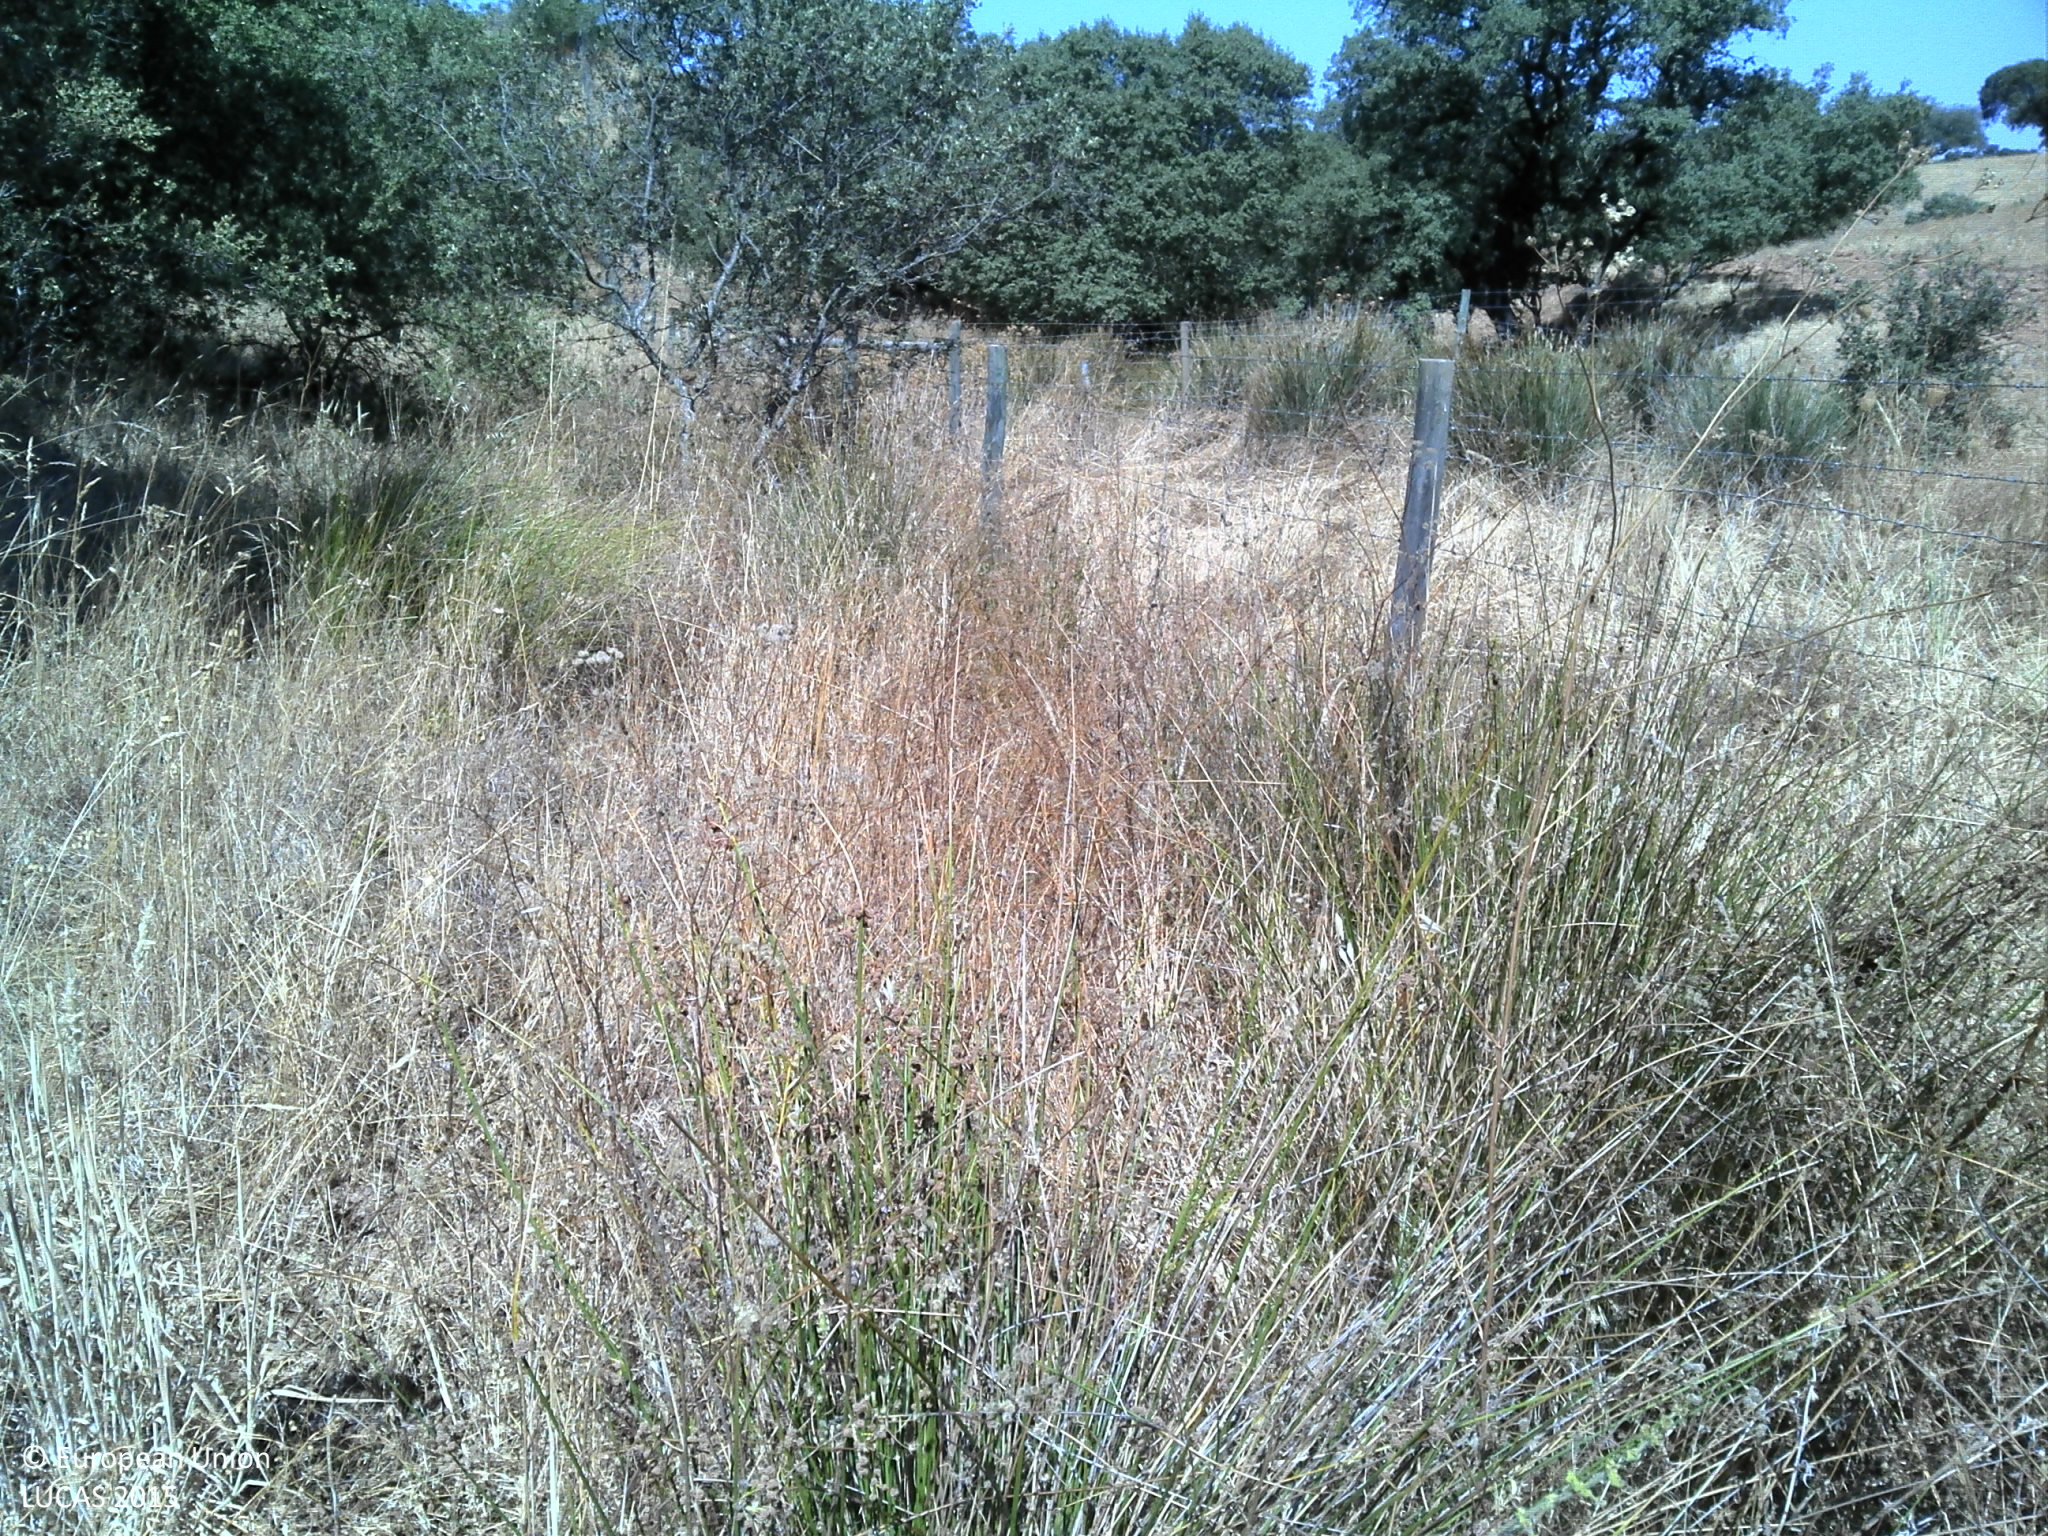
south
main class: Grassland
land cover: Grassland without tree/shrub cover
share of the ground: > 75 %
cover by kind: herbaceous plants 85 %, unconsolidated bare surface 15 %
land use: Agriculture (excluding fallow land and kitchen gardens)
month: August
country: PT
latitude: 37.8820
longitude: -7.8176
